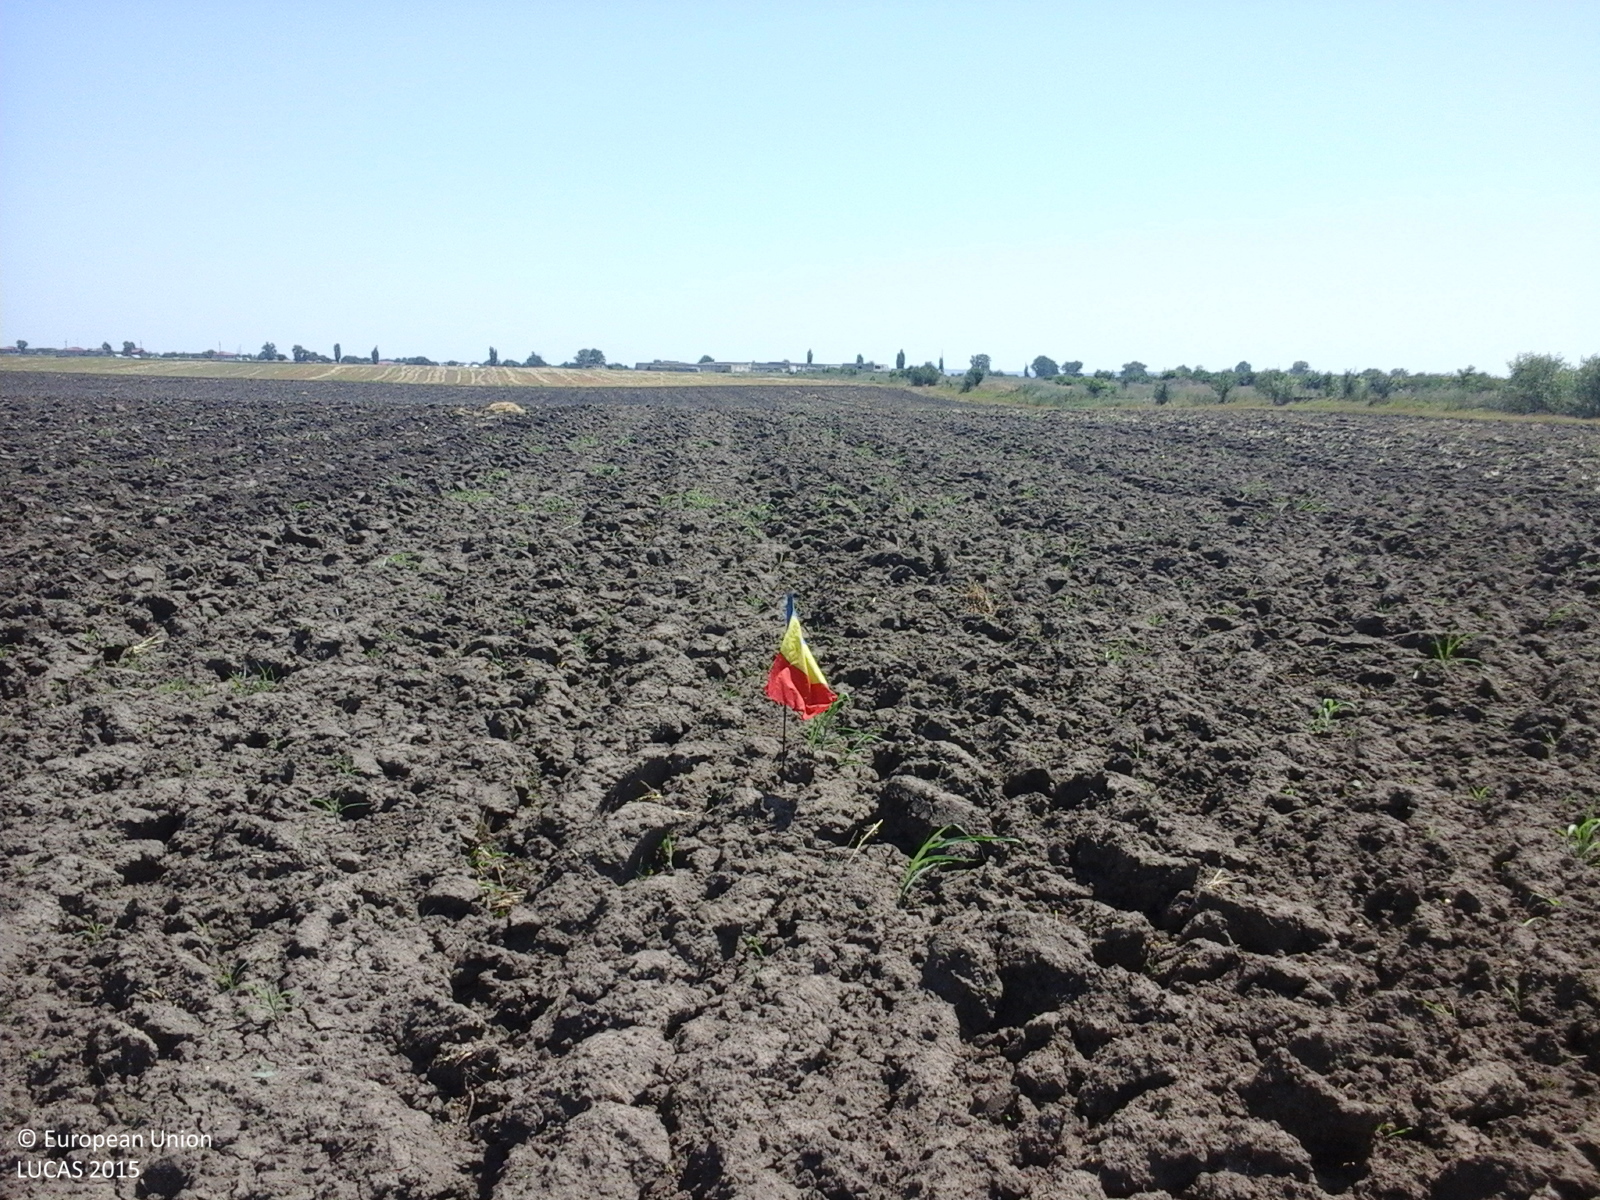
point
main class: Cropland
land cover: Durum wheat
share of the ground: < 10 %
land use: Agriculture (excluding fallow land and kitchen gardens)
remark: Harvested field
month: July
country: RO
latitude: 44.1295
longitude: 26.6762
